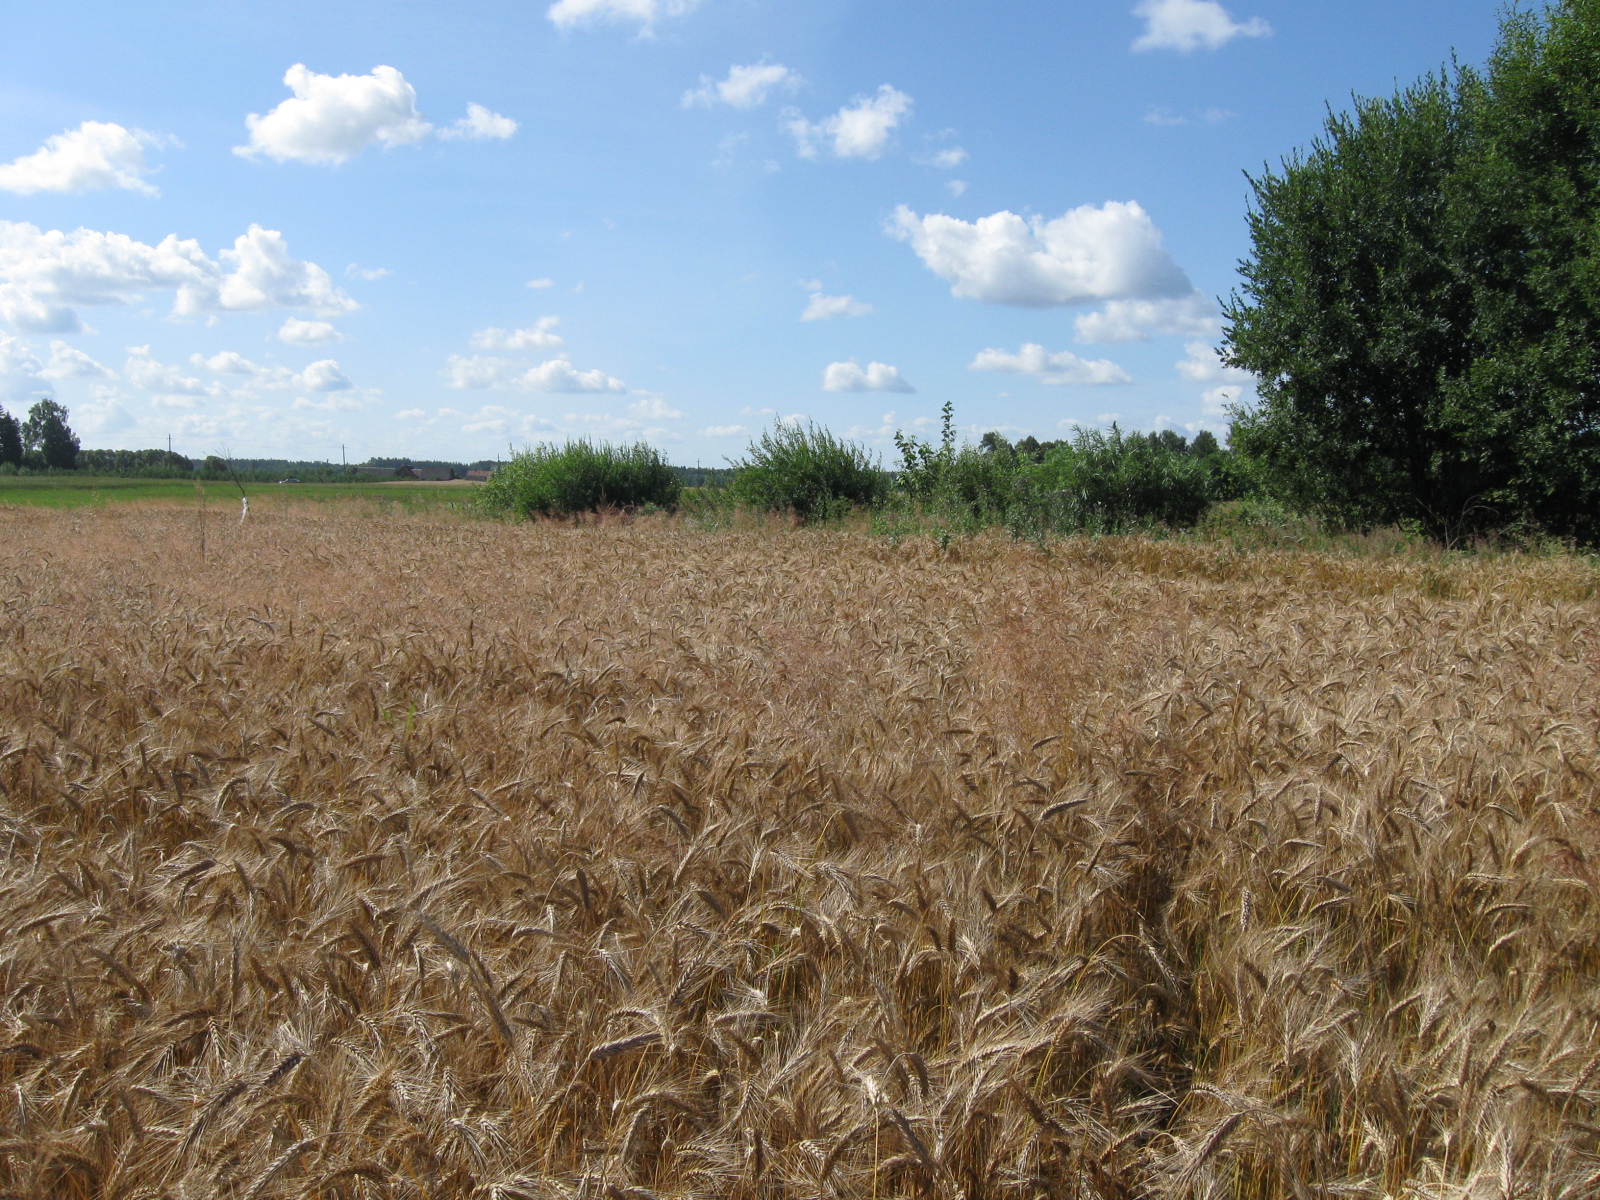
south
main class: Cropland
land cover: Durum wheat
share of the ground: > 75 %
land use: Agriculture (excluding fallow land and kitchen gardens)
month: July
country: LT
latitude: 55.0296
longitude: 23.5196
